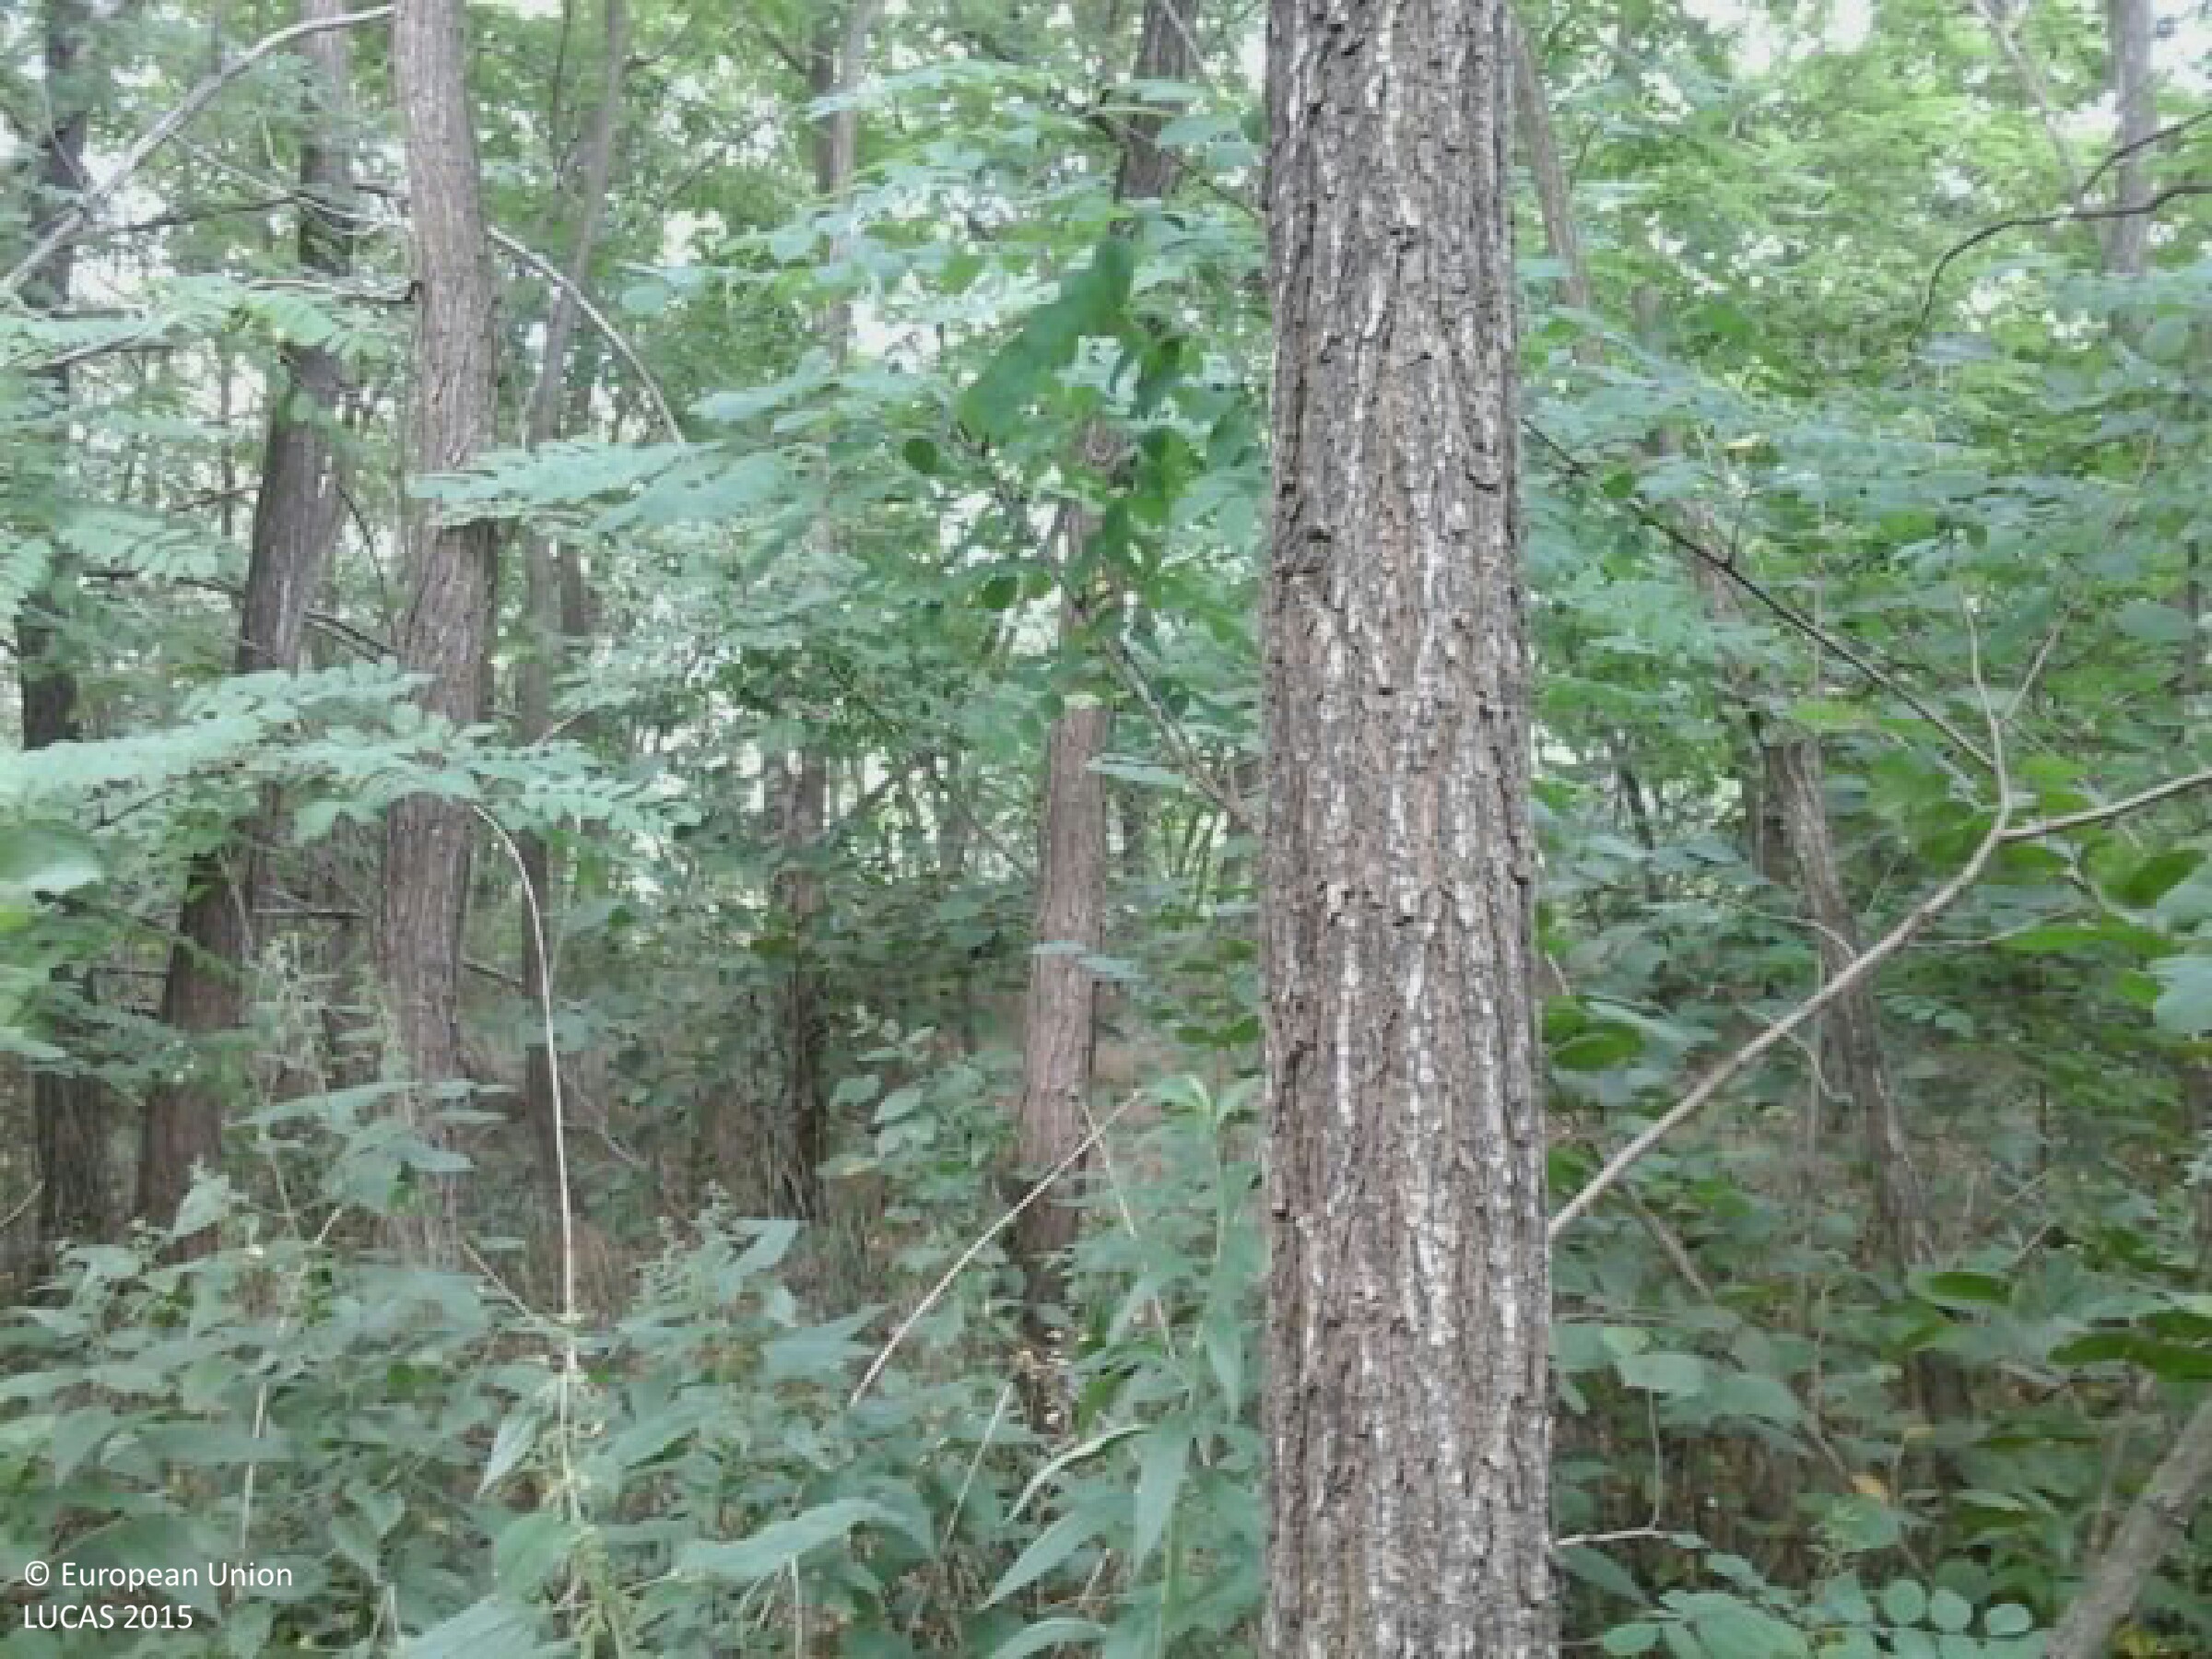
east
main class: Woodland
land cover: Broadleaved woodland
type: exotic forest
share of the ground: > 75 %
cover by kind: broadleaved forest trees 90 %, shrubs 5 %, herbaceous plants 5 %
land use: Forestry
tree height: > 5 m
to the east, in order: Broadleaved woodland; Grass margins; Paved roads, cycling and walking lanes; Grass margins; Broadleaved woodland; Grassland without tree/shrub cover; Electric lines; Grassland without tree/shrub cover; Tracks; Grassland without tree/shrub cover; Electric lines; Grassland without tree/shrub cover
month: July
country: HU
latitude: 46.4689
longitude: 16.9437
